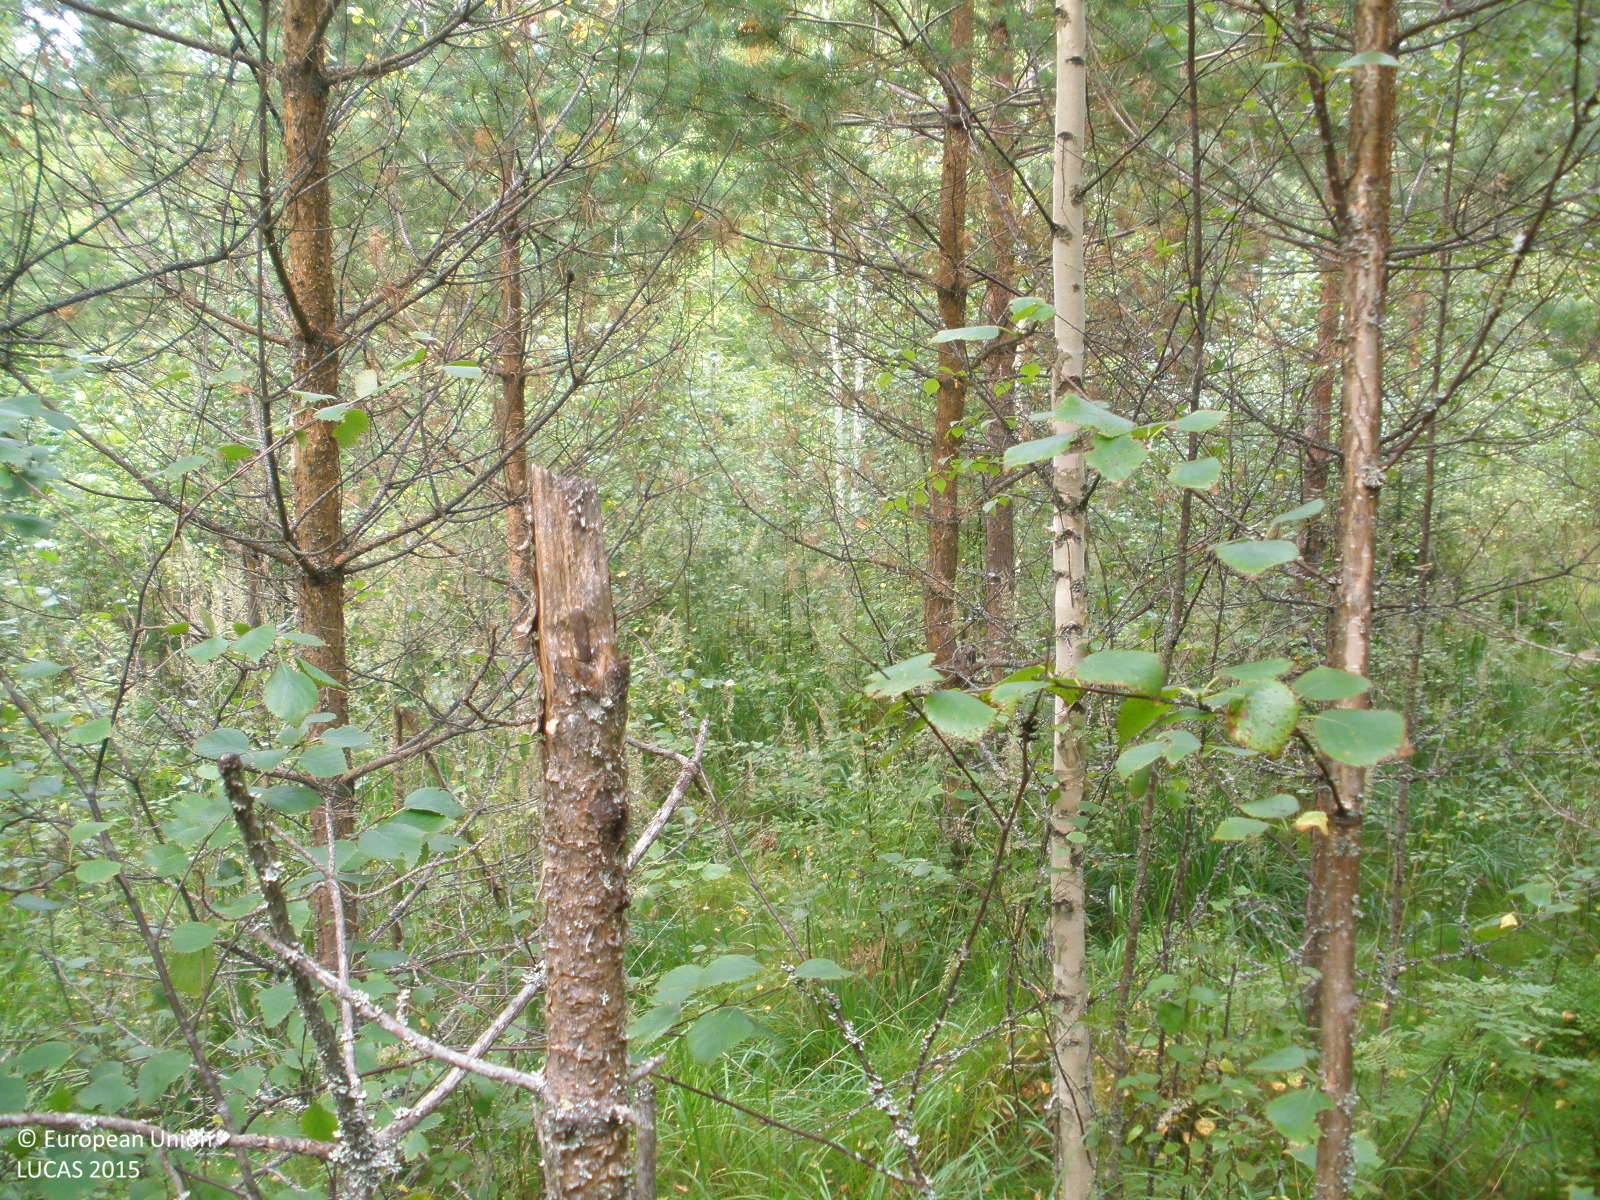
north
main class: Woodland
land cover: Pine dominated mixed woodland
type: boreal forest
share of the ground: 50 - 75 %
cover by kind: coniferous forest trees 40 %, broadleaved forest trees 25 %, herbaceous plants 25 %, shrubs 5 %, lichens and mosses 5 %
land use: Forestry
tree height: > 5 m
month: August
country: FI
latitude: 60.7892
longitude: 24.4495
